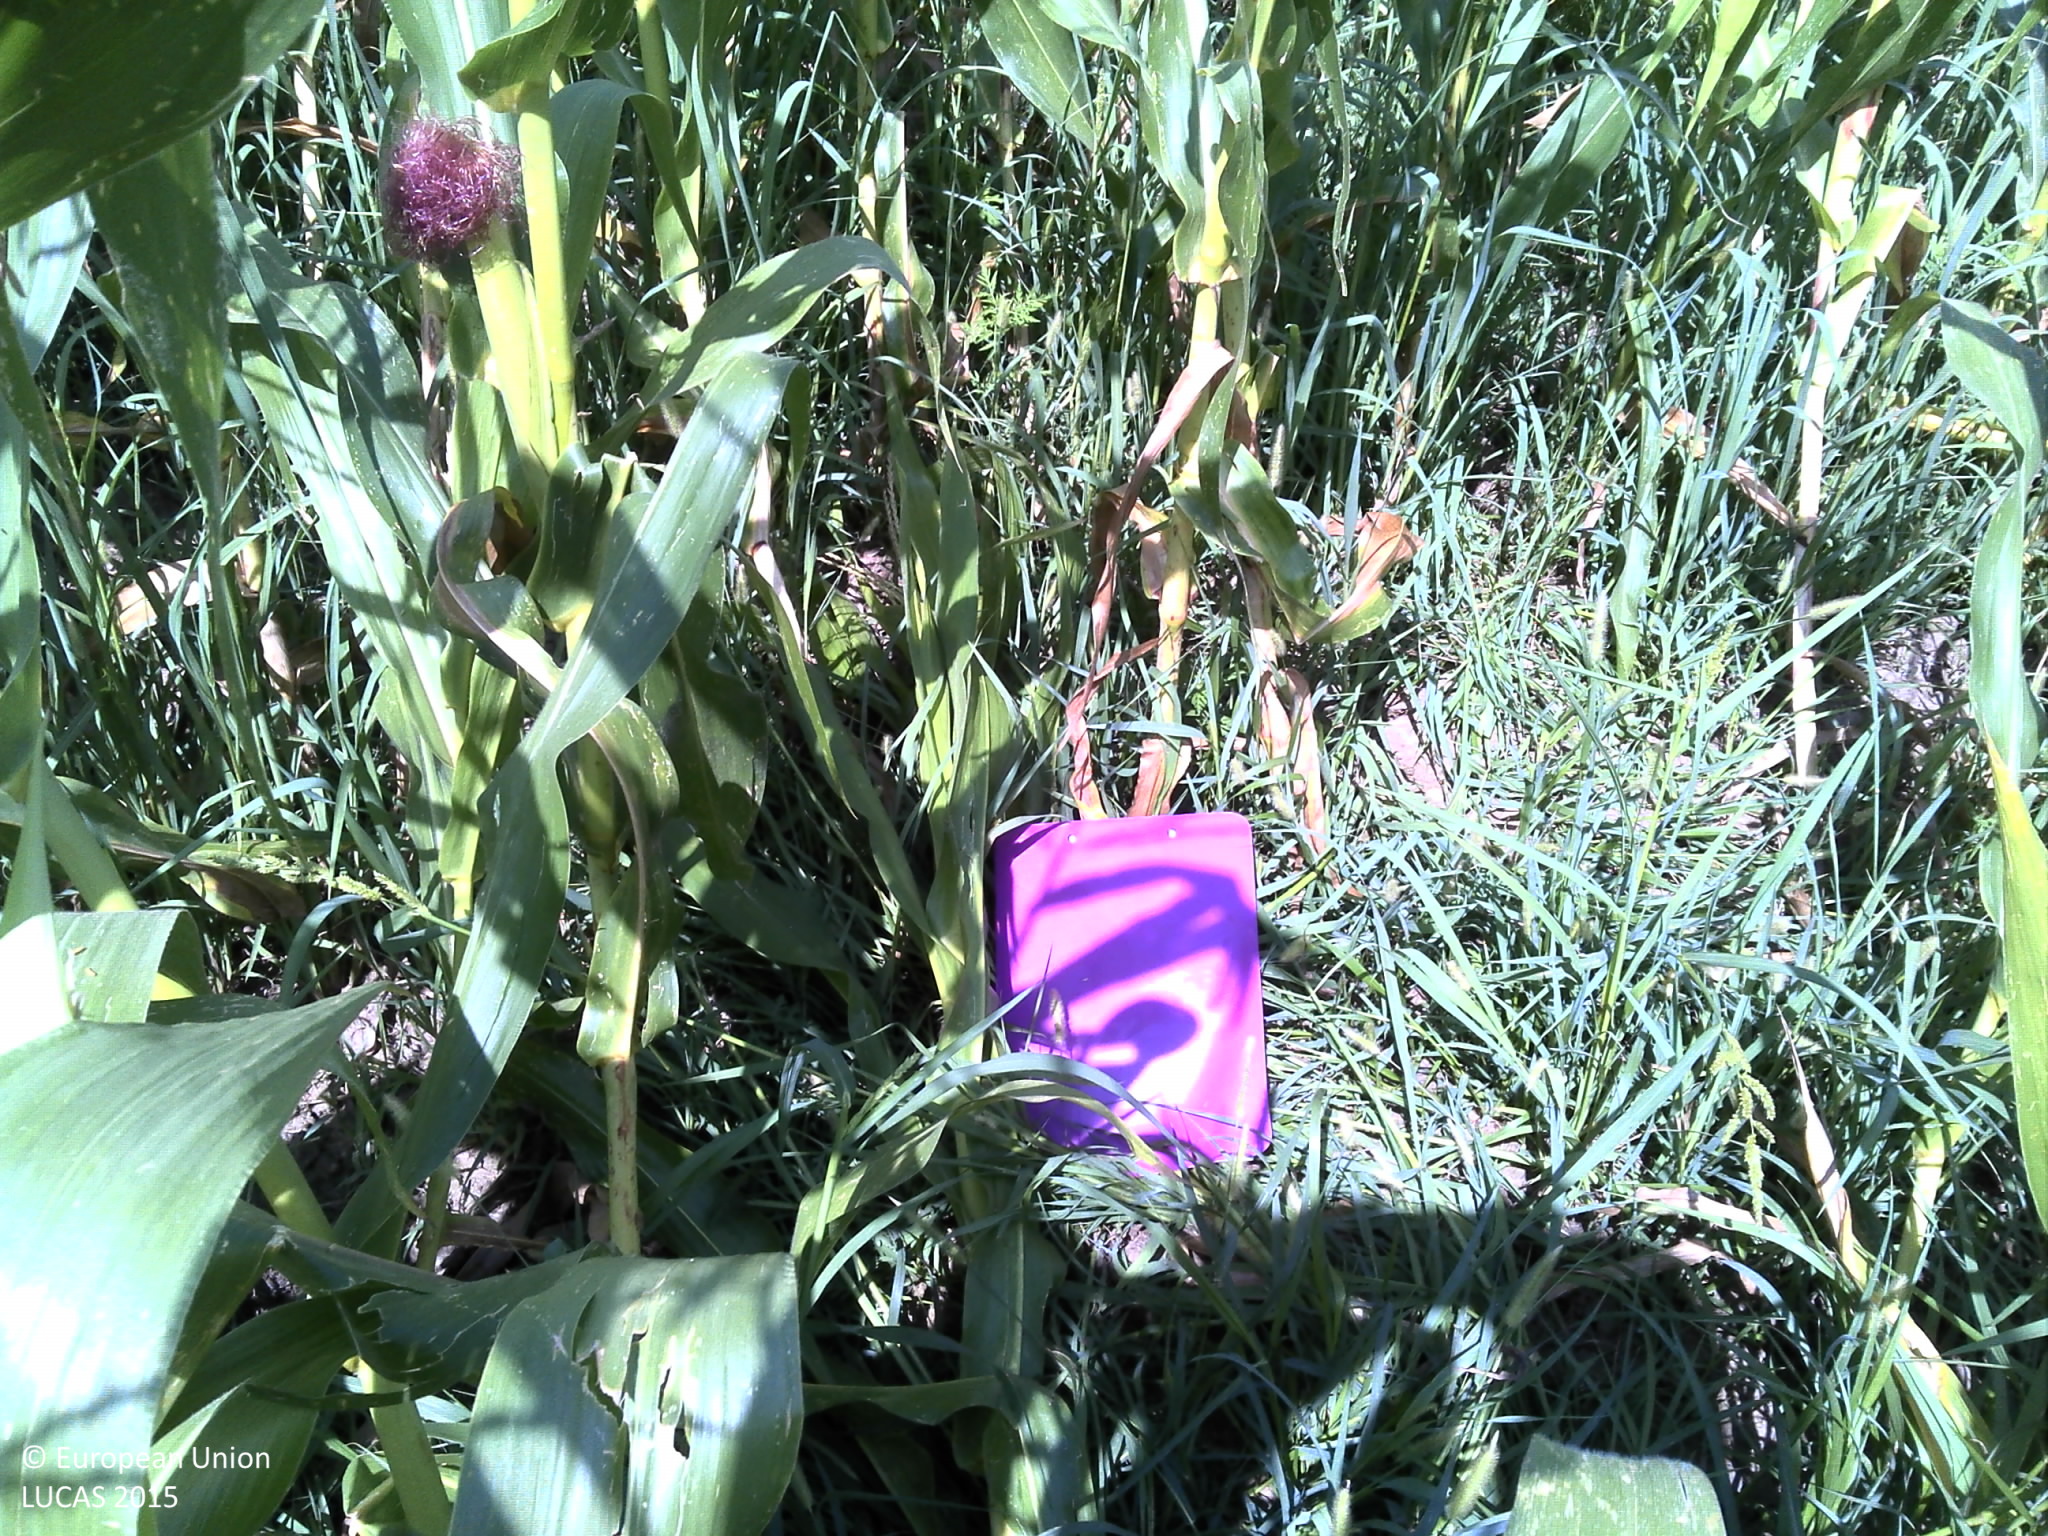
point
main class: Cropland
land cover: Maize
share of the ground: > 75 %
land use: Agriculture (excluding fallow land and kitchen gardens)
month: August
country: HR
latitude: 45.5528
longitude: 16.5699
